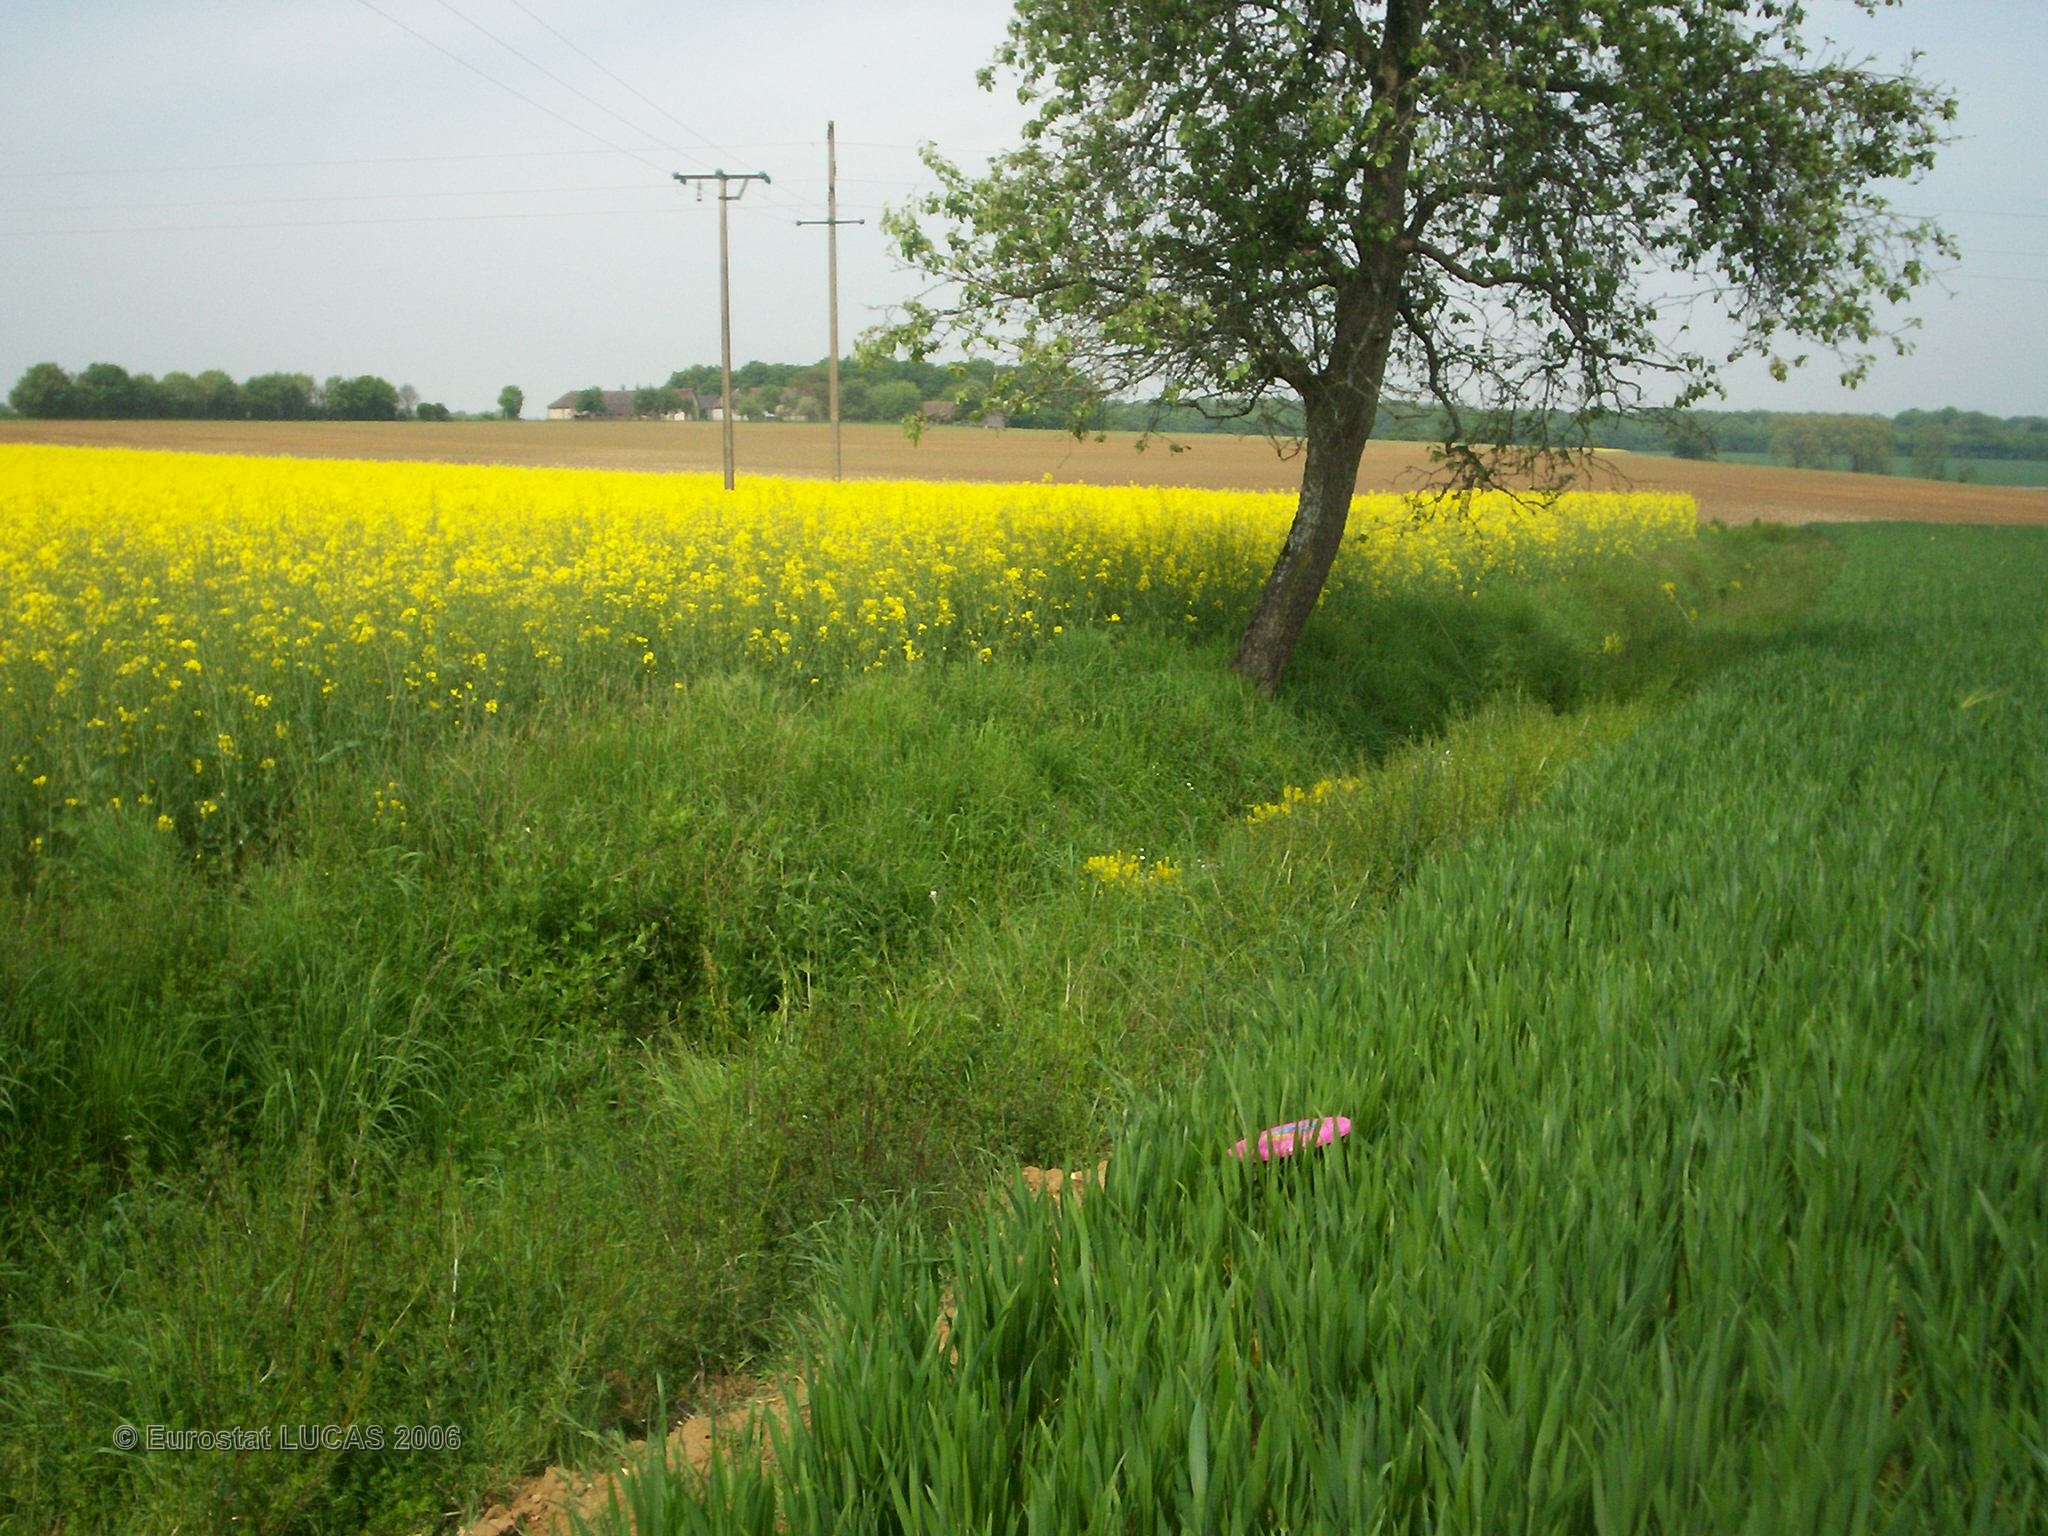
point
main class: Cropland
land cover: Common wheat
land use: Agriculture (excluding fallow land and kitchen gardens)
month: May
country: FR
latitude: 47.7279
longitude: 2.9671
